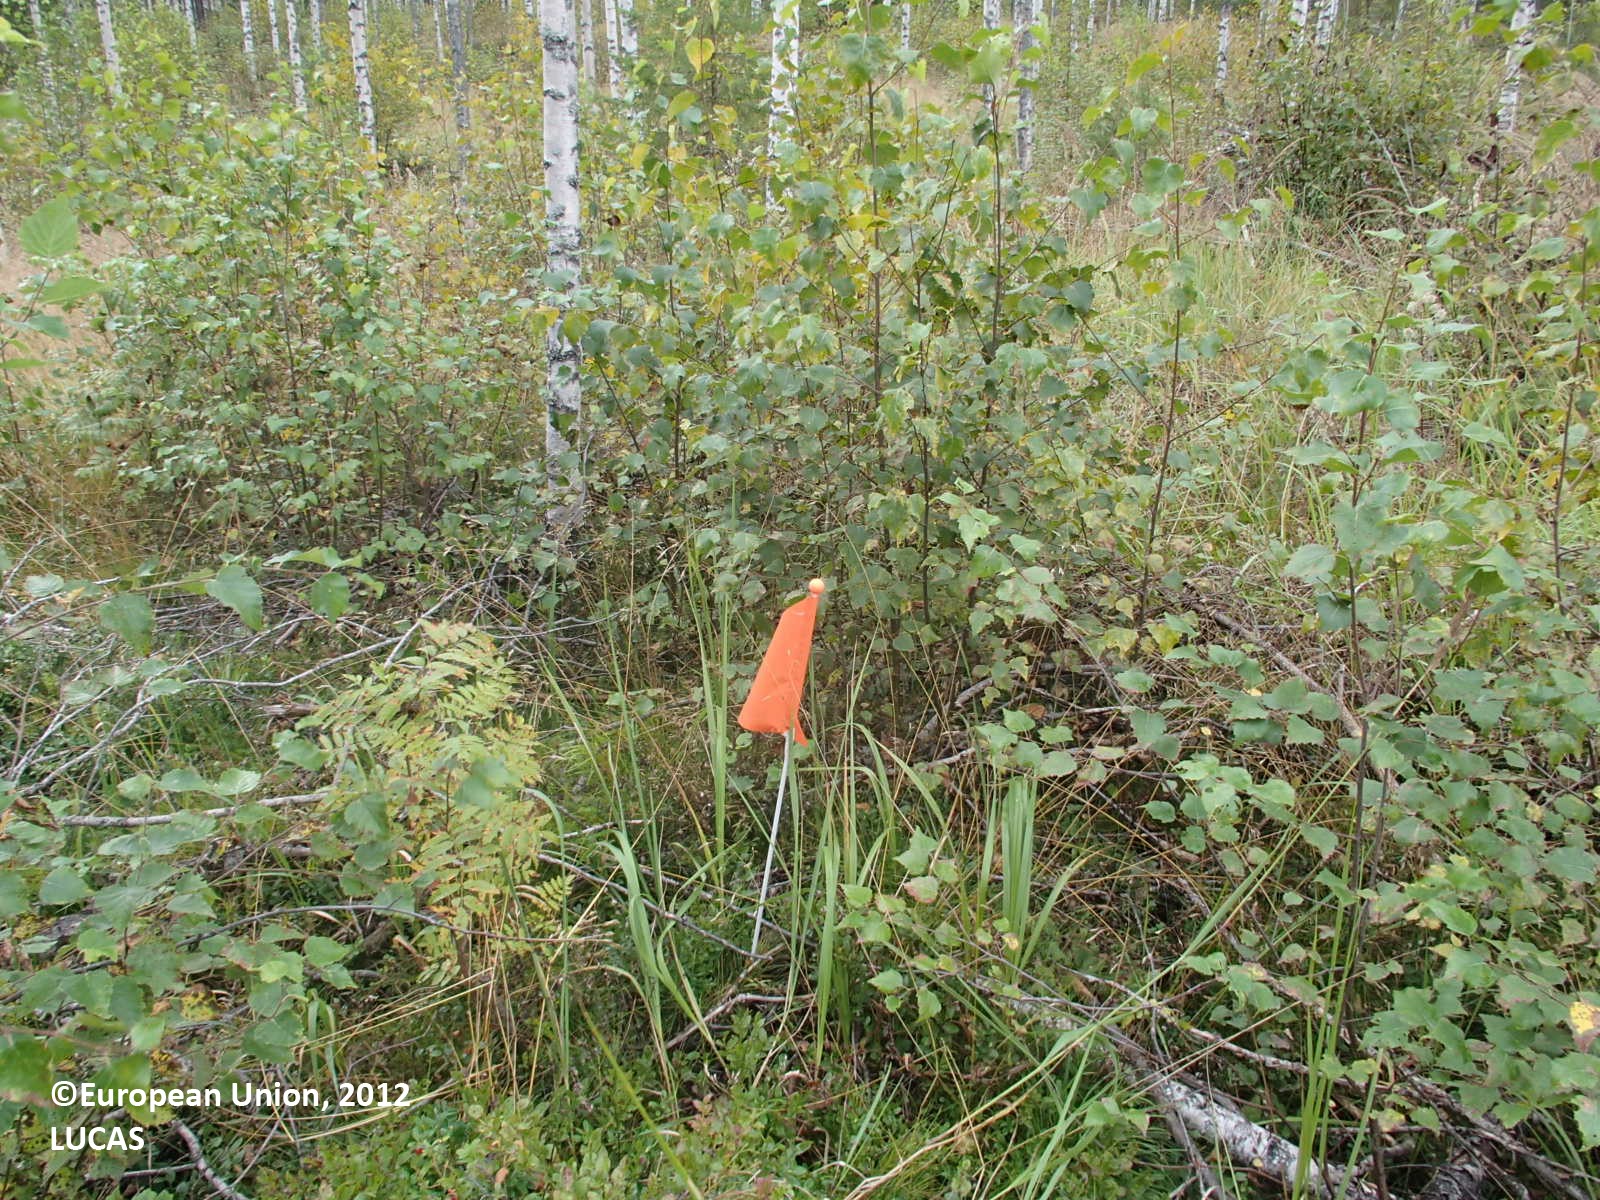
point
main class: Woodland
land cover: Spruce dominated mixed woodland
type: boreal forest
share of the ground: > 75 %
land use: Forestry
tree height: > 5 m
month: August
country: FI
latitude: 63.4769
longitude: 27.1046
